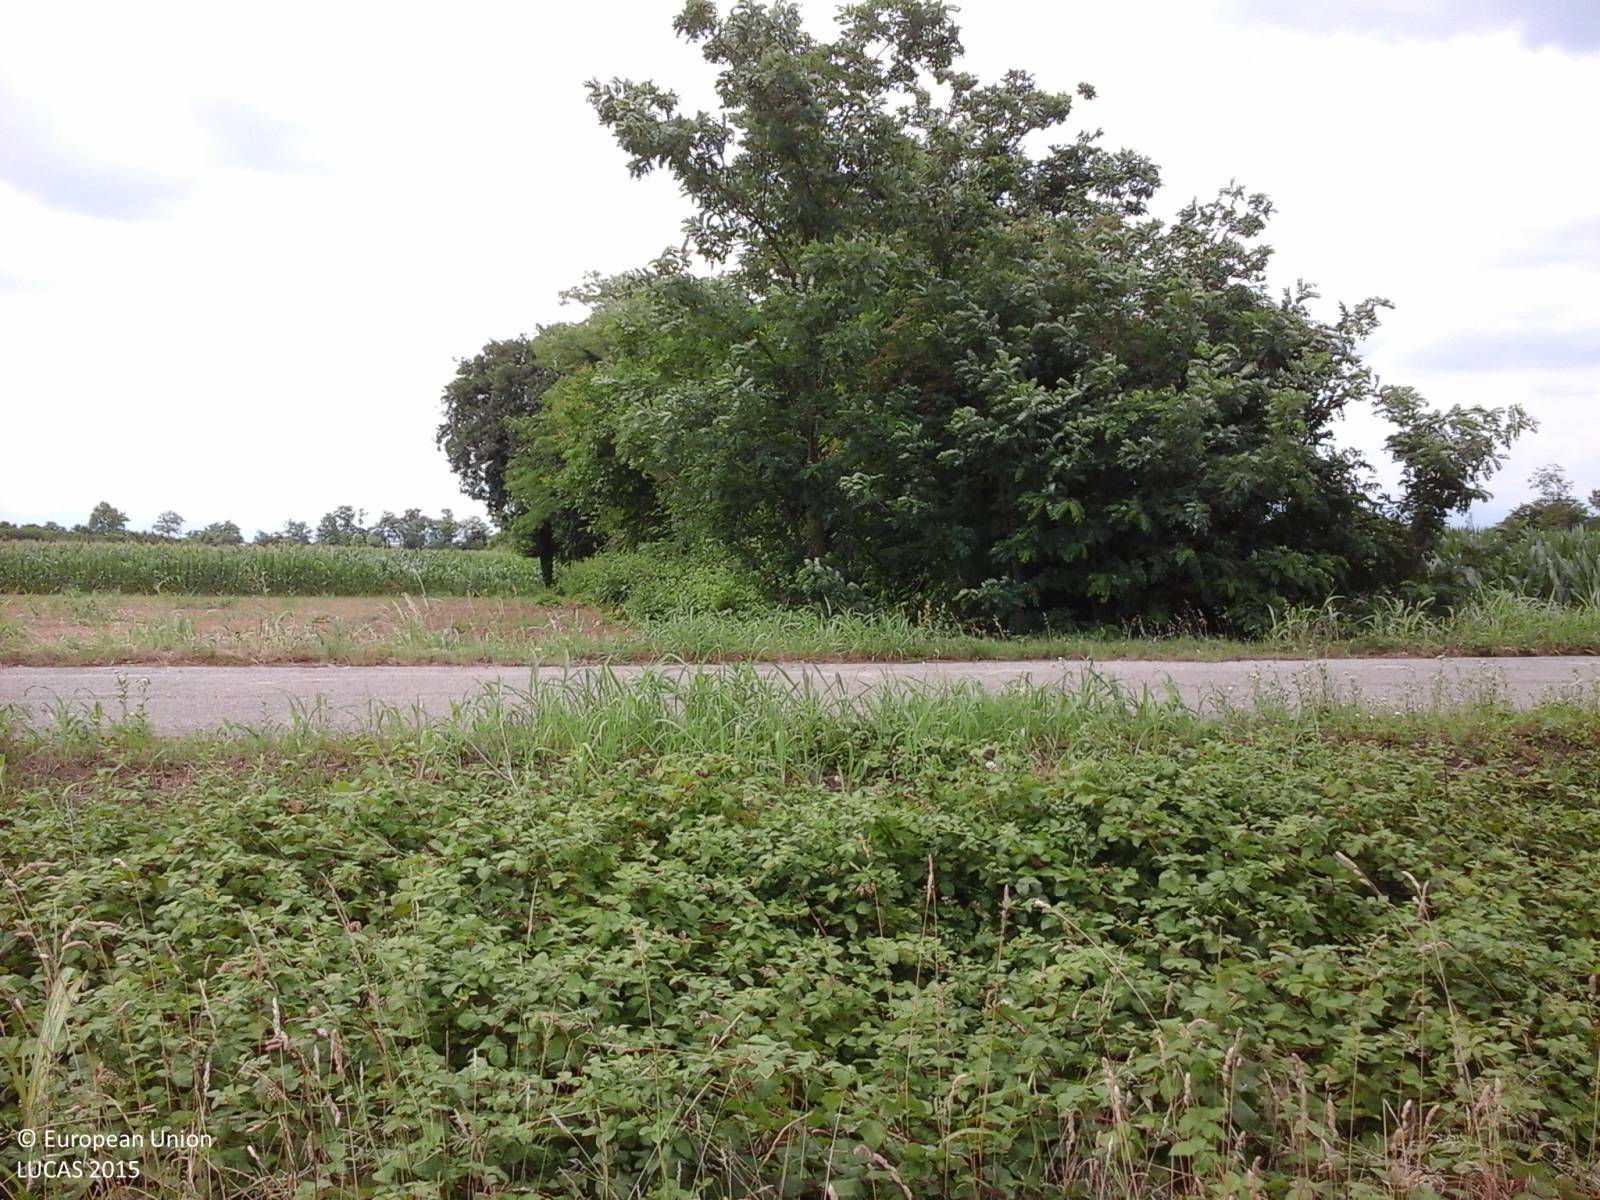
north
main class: Cropland
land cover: Soya
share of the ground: 10 - 25 %
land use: Agriculture (excluding fallow land and kitchen gardens)
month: June
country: IT
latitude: 45.9958
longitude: 13.2371
